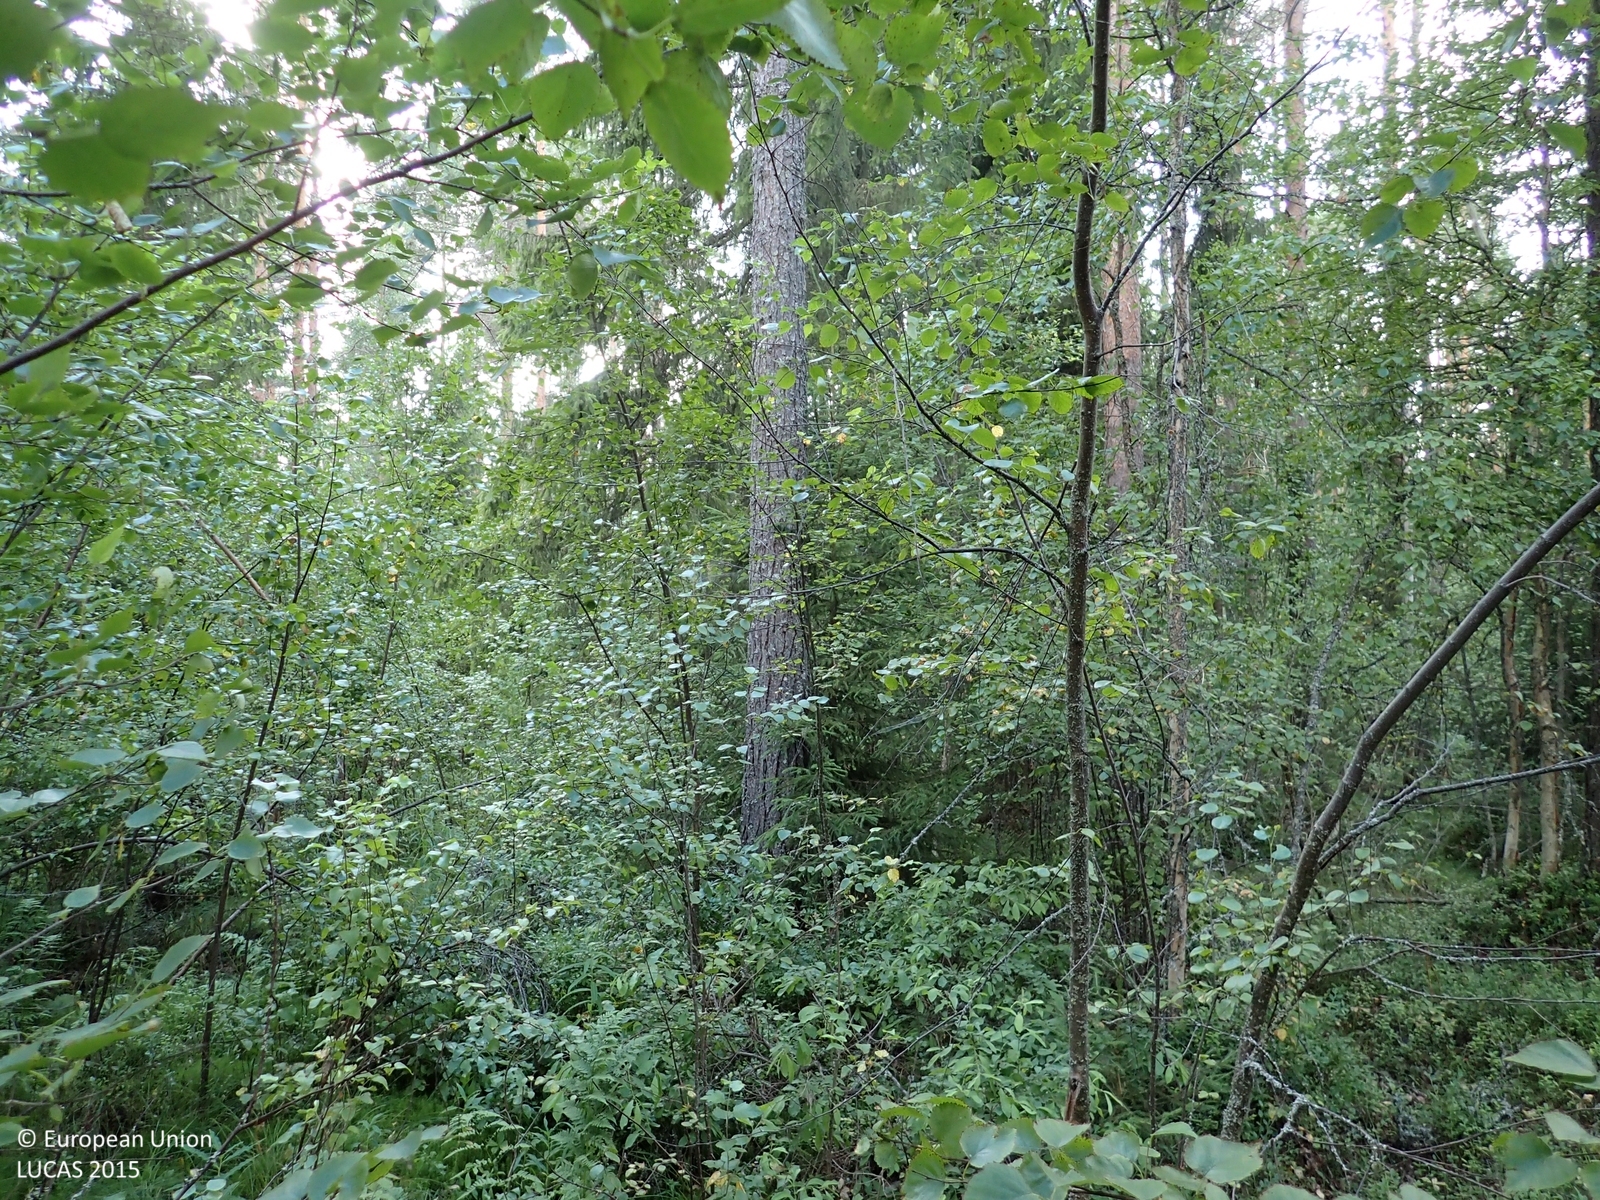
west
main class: Woodland
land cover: Pine dominated mixed woodland
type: boreal forest
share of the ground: > 75 %
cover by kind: coniferous forest trees 60 %, broadleaved forest trees 20 %, shrubs 15 %, herbaceous plants 5 %
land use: Forestry
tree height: > 5 m
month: August
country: FI
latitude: 62.7513
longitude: 22.0091
